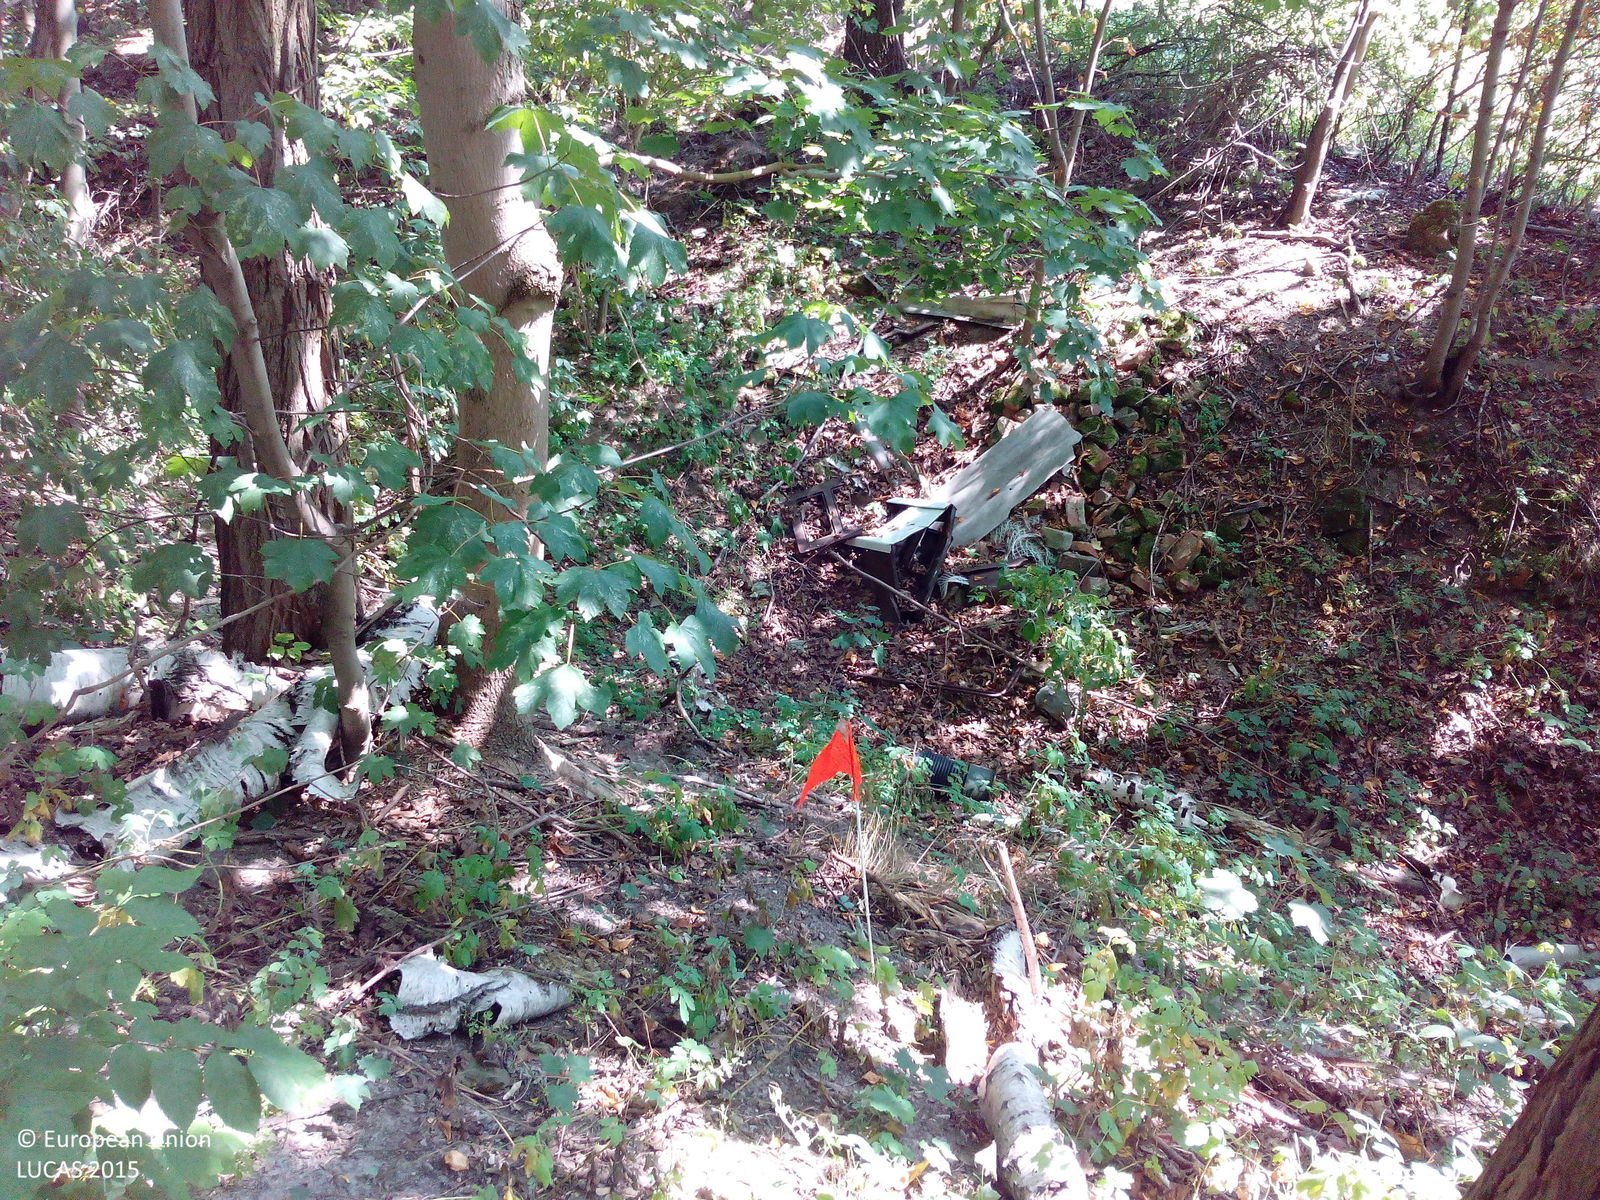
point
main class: Woodland
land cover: Broadleaved woodland
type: mesophytic deciduous forest
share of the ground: > 75 %
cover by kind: broadleaved forest trees 95 %, unconsolidated bare surface 5 %
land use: Forestry
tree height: > 5 m
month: August
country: DE
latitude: 51.8697
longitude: 11.0309
